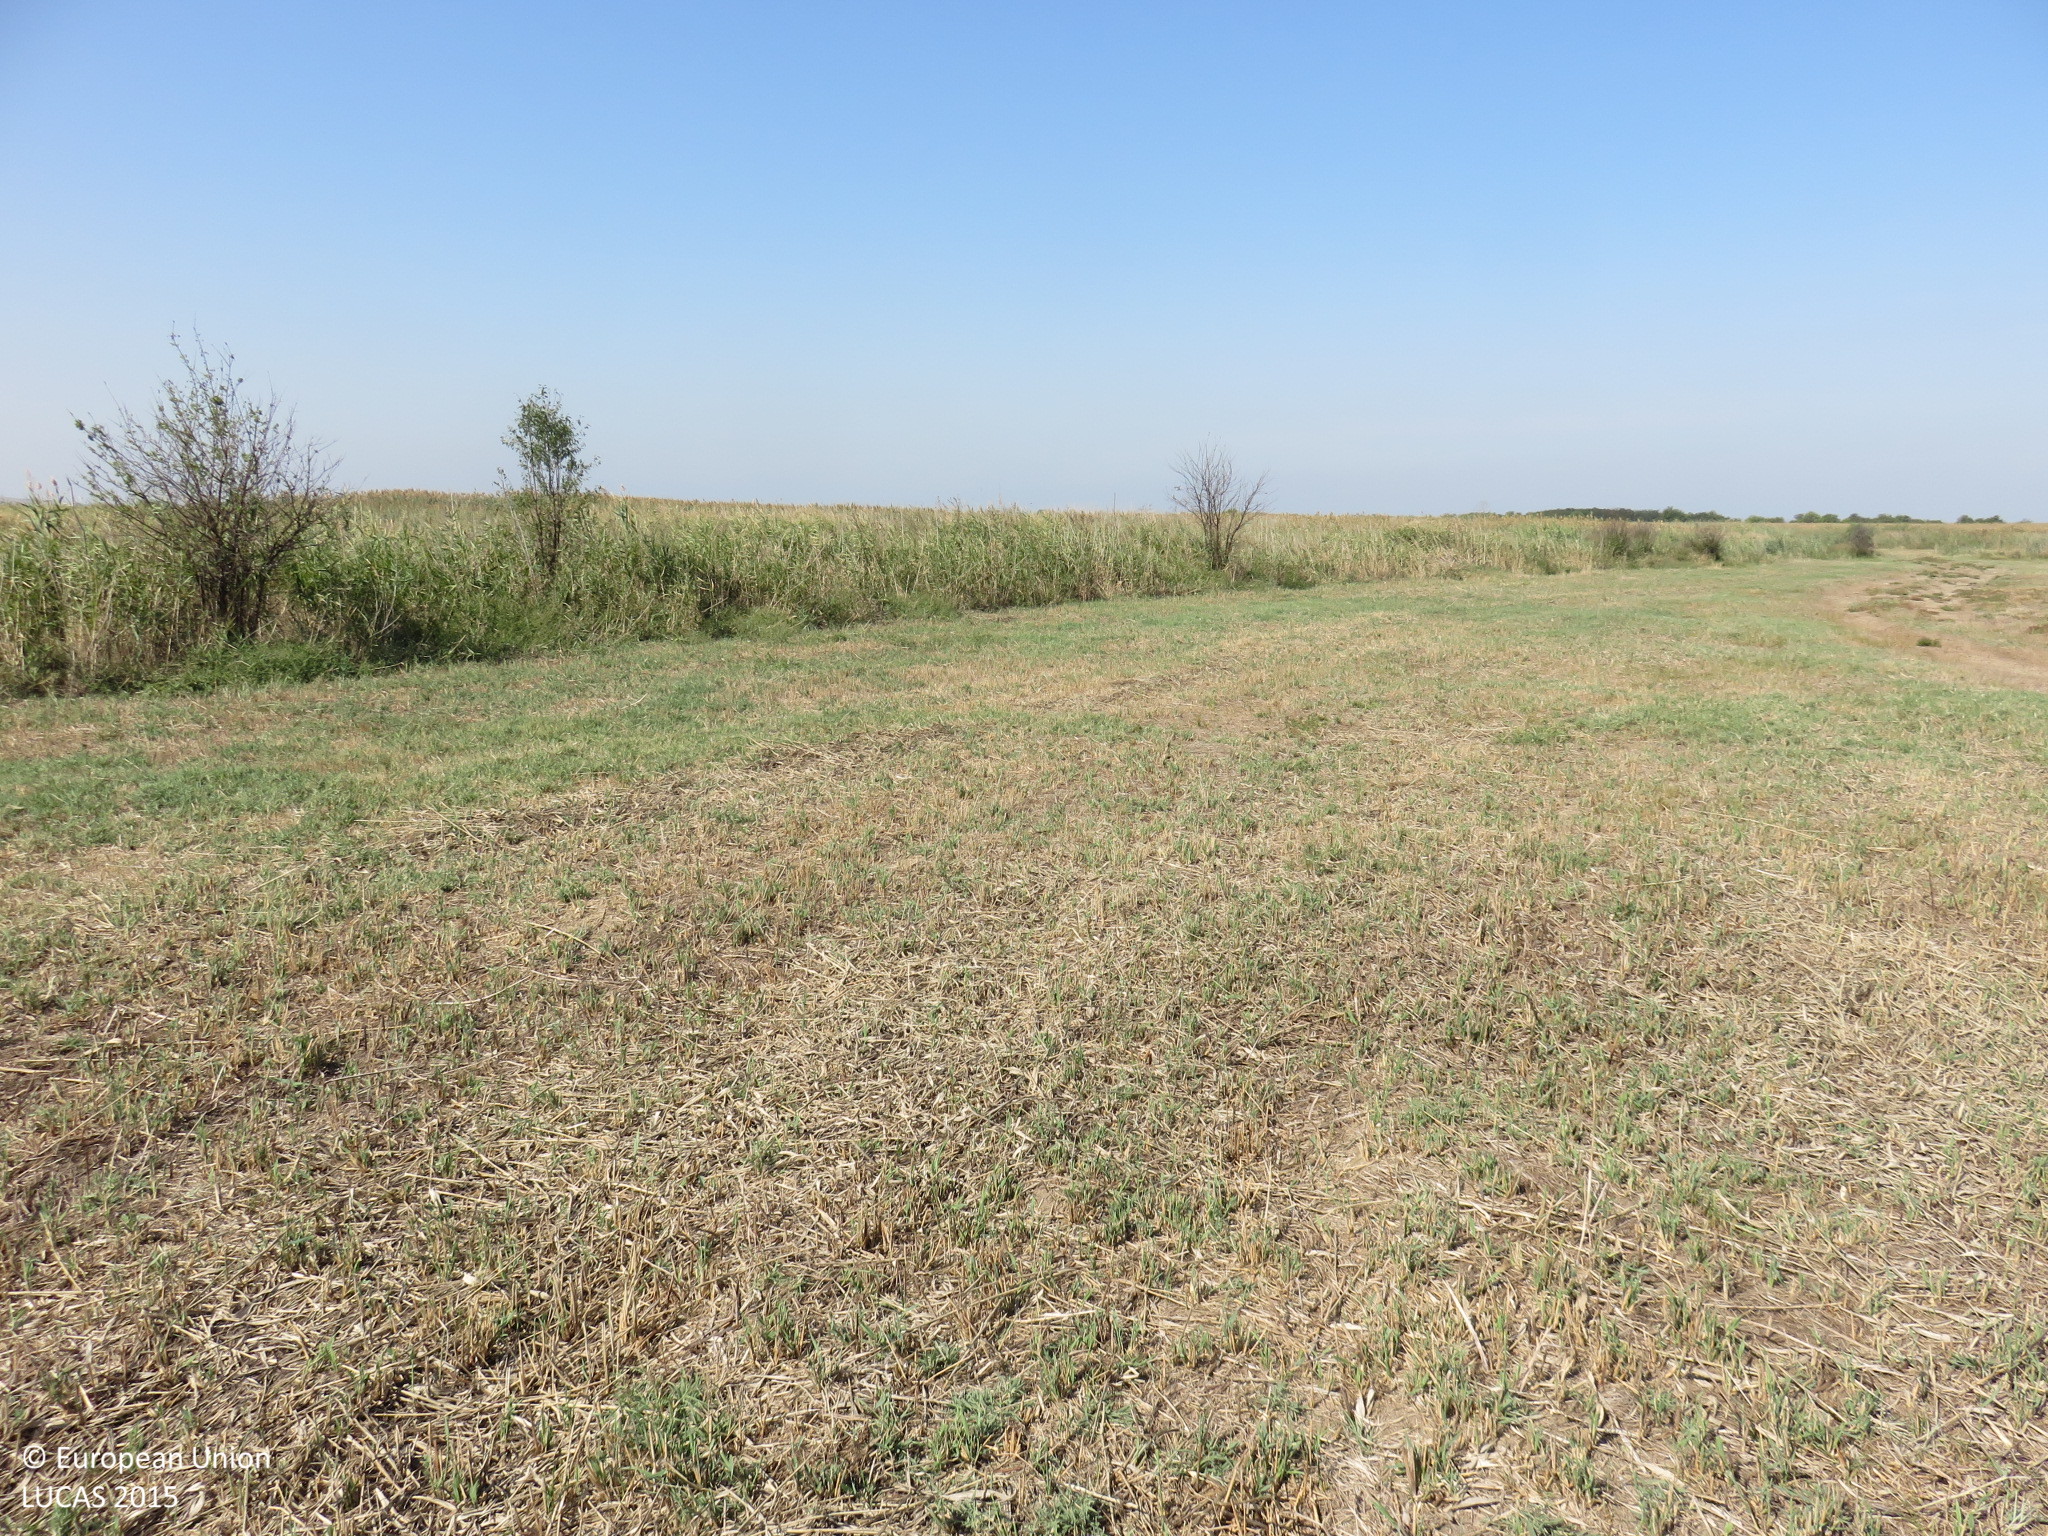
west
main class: Grassland
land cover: Grassland without tree/shrub cover
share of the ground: > 75 %
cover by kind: herbaceous plants 100 %
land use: Agriculture (excluding fallow land and kitchen gardens)
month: September
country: BG
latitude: 43.7177
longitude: 24.5750
